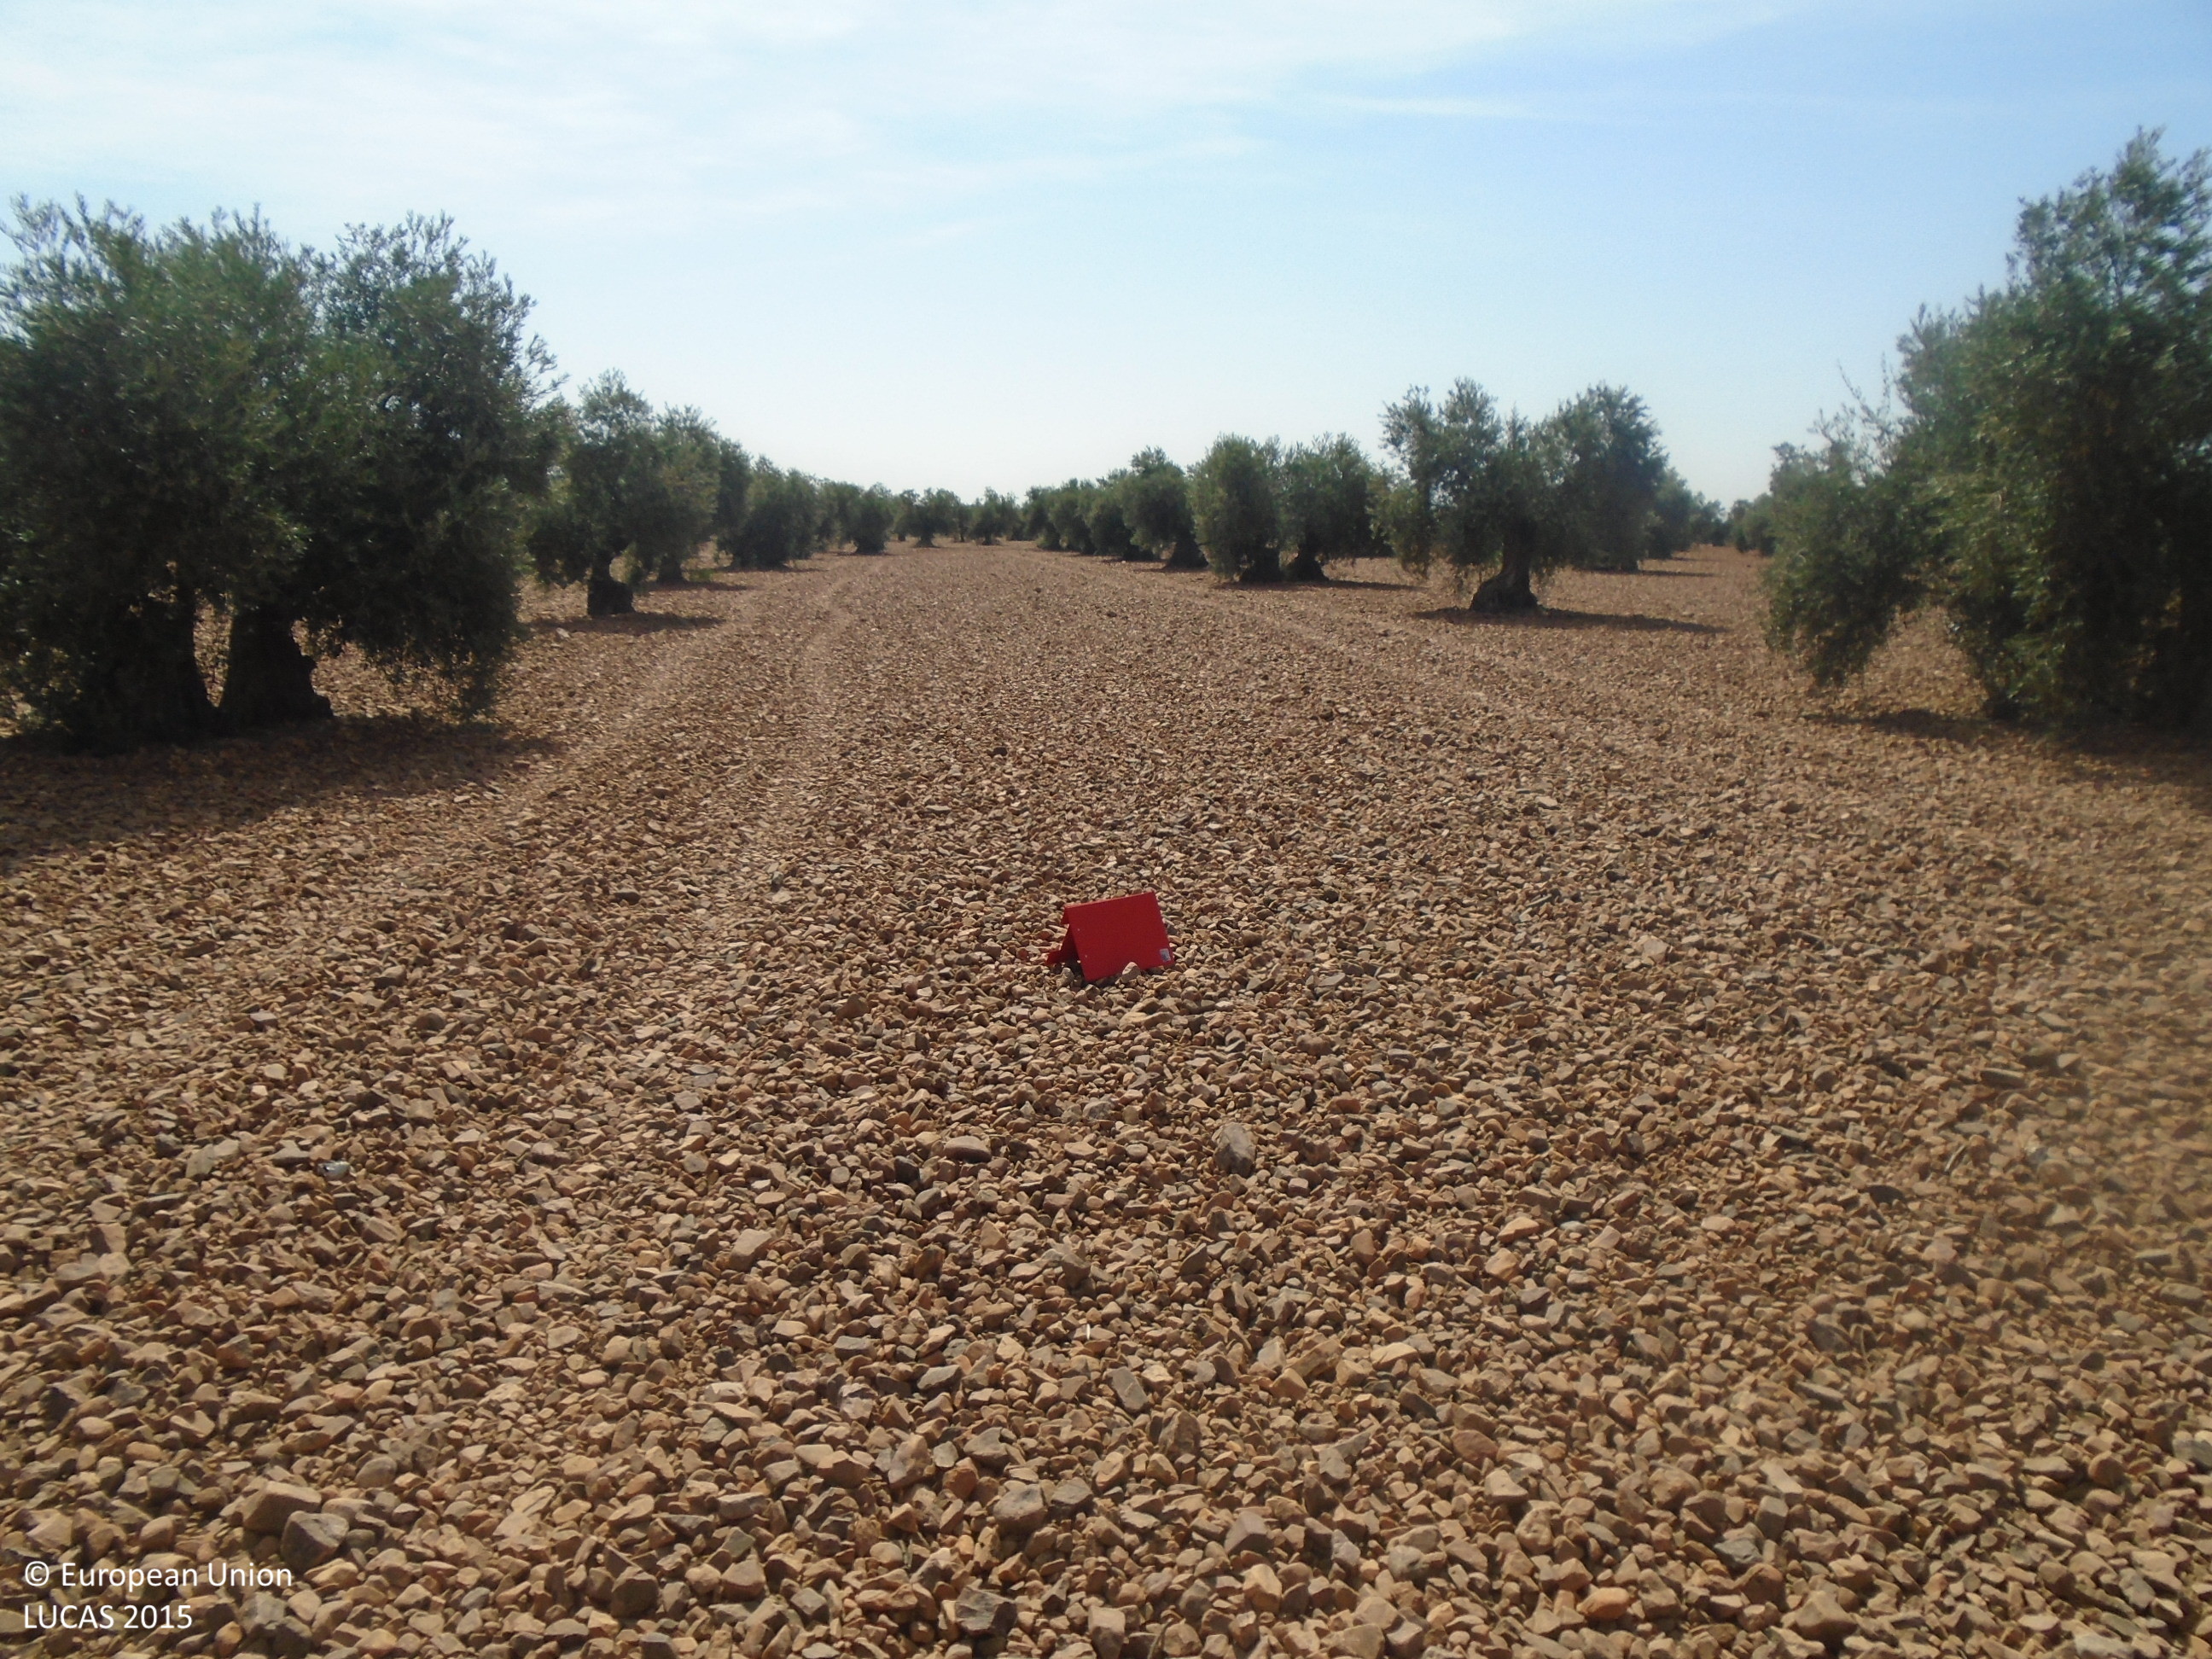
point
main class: Cropland
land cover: Olive groves
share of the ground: 25 - 50 %
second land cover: Other bare soil
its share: > 75 %
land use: Agriculture (excluding fallow land and kitchen gardens)
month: July
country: ES
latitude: 39.4137
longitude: -3.5531
